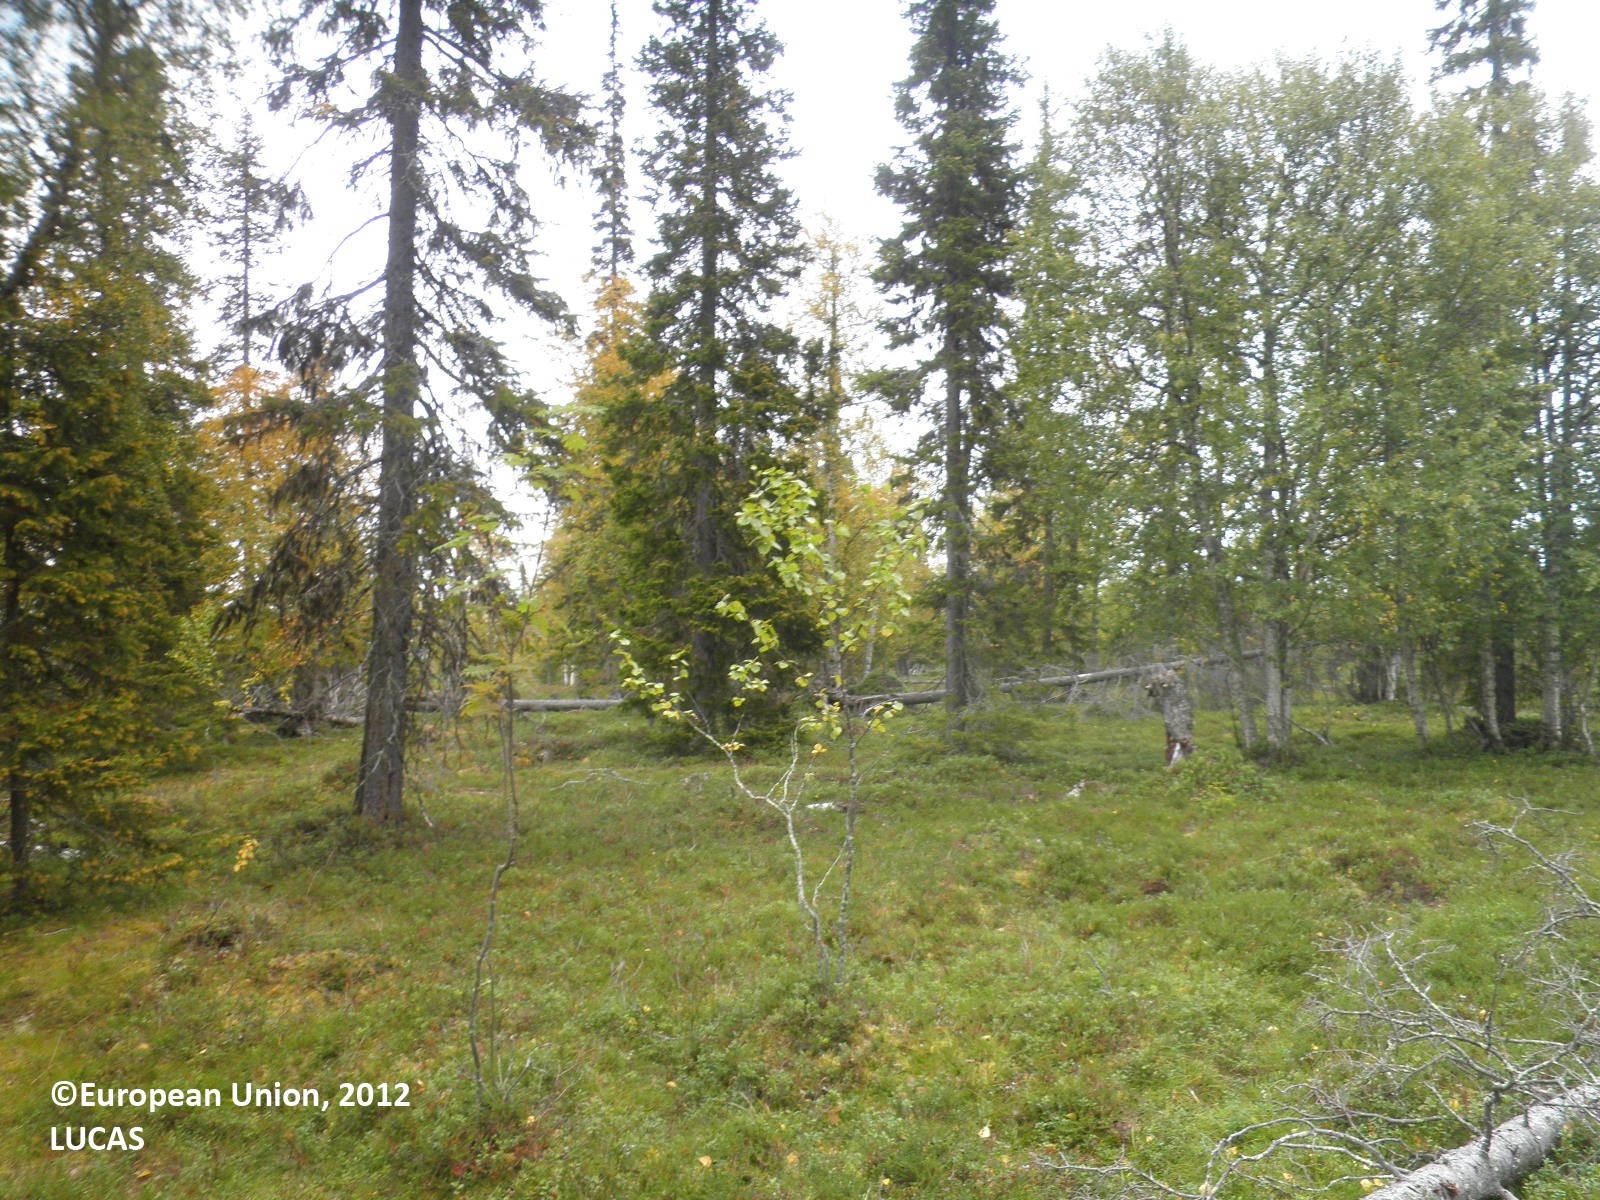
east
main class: Woodland
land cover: Spruce dominated mixed woodland
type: boreal forest
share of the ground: 50 - 75 %
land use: Forestry
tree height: > 5 m
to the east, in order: Spruce dominated mixed woodland; Pine dominated coniferous woodland
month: August
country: FI
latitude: 67.5787
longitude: 27.9900
